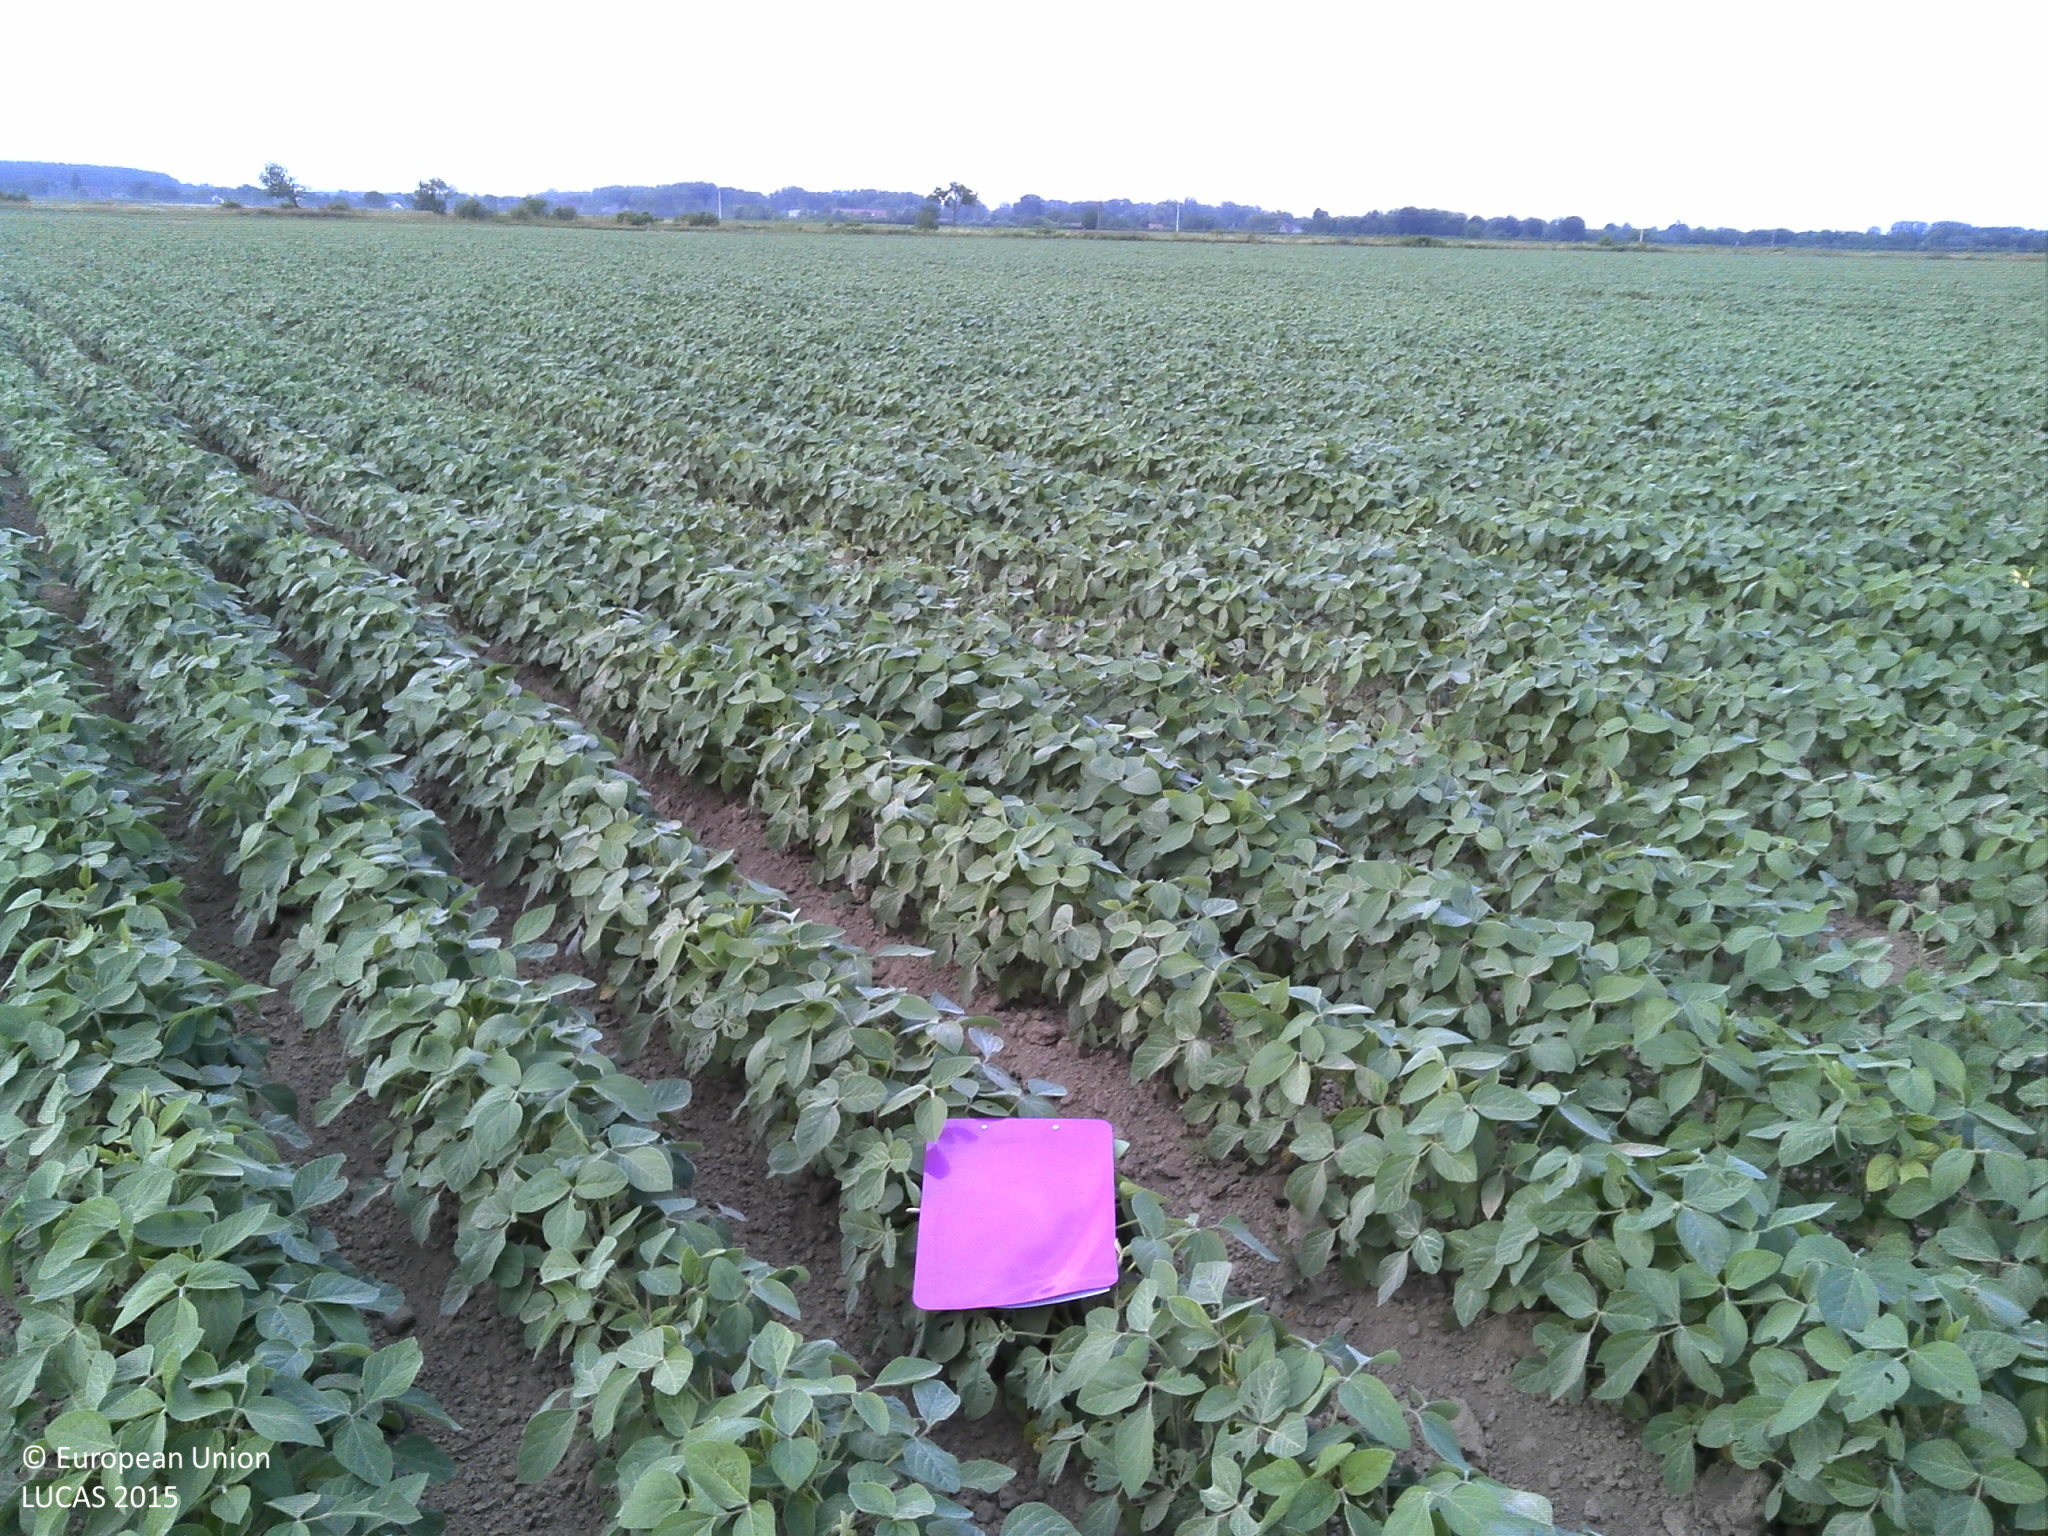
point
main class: Cropland
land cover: Soya
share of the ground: 50 - 75 %
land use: Agriculture (excluding fallow land and kitchen gardens)
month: June
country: HR
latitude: 45.7250
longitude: 18.2420
